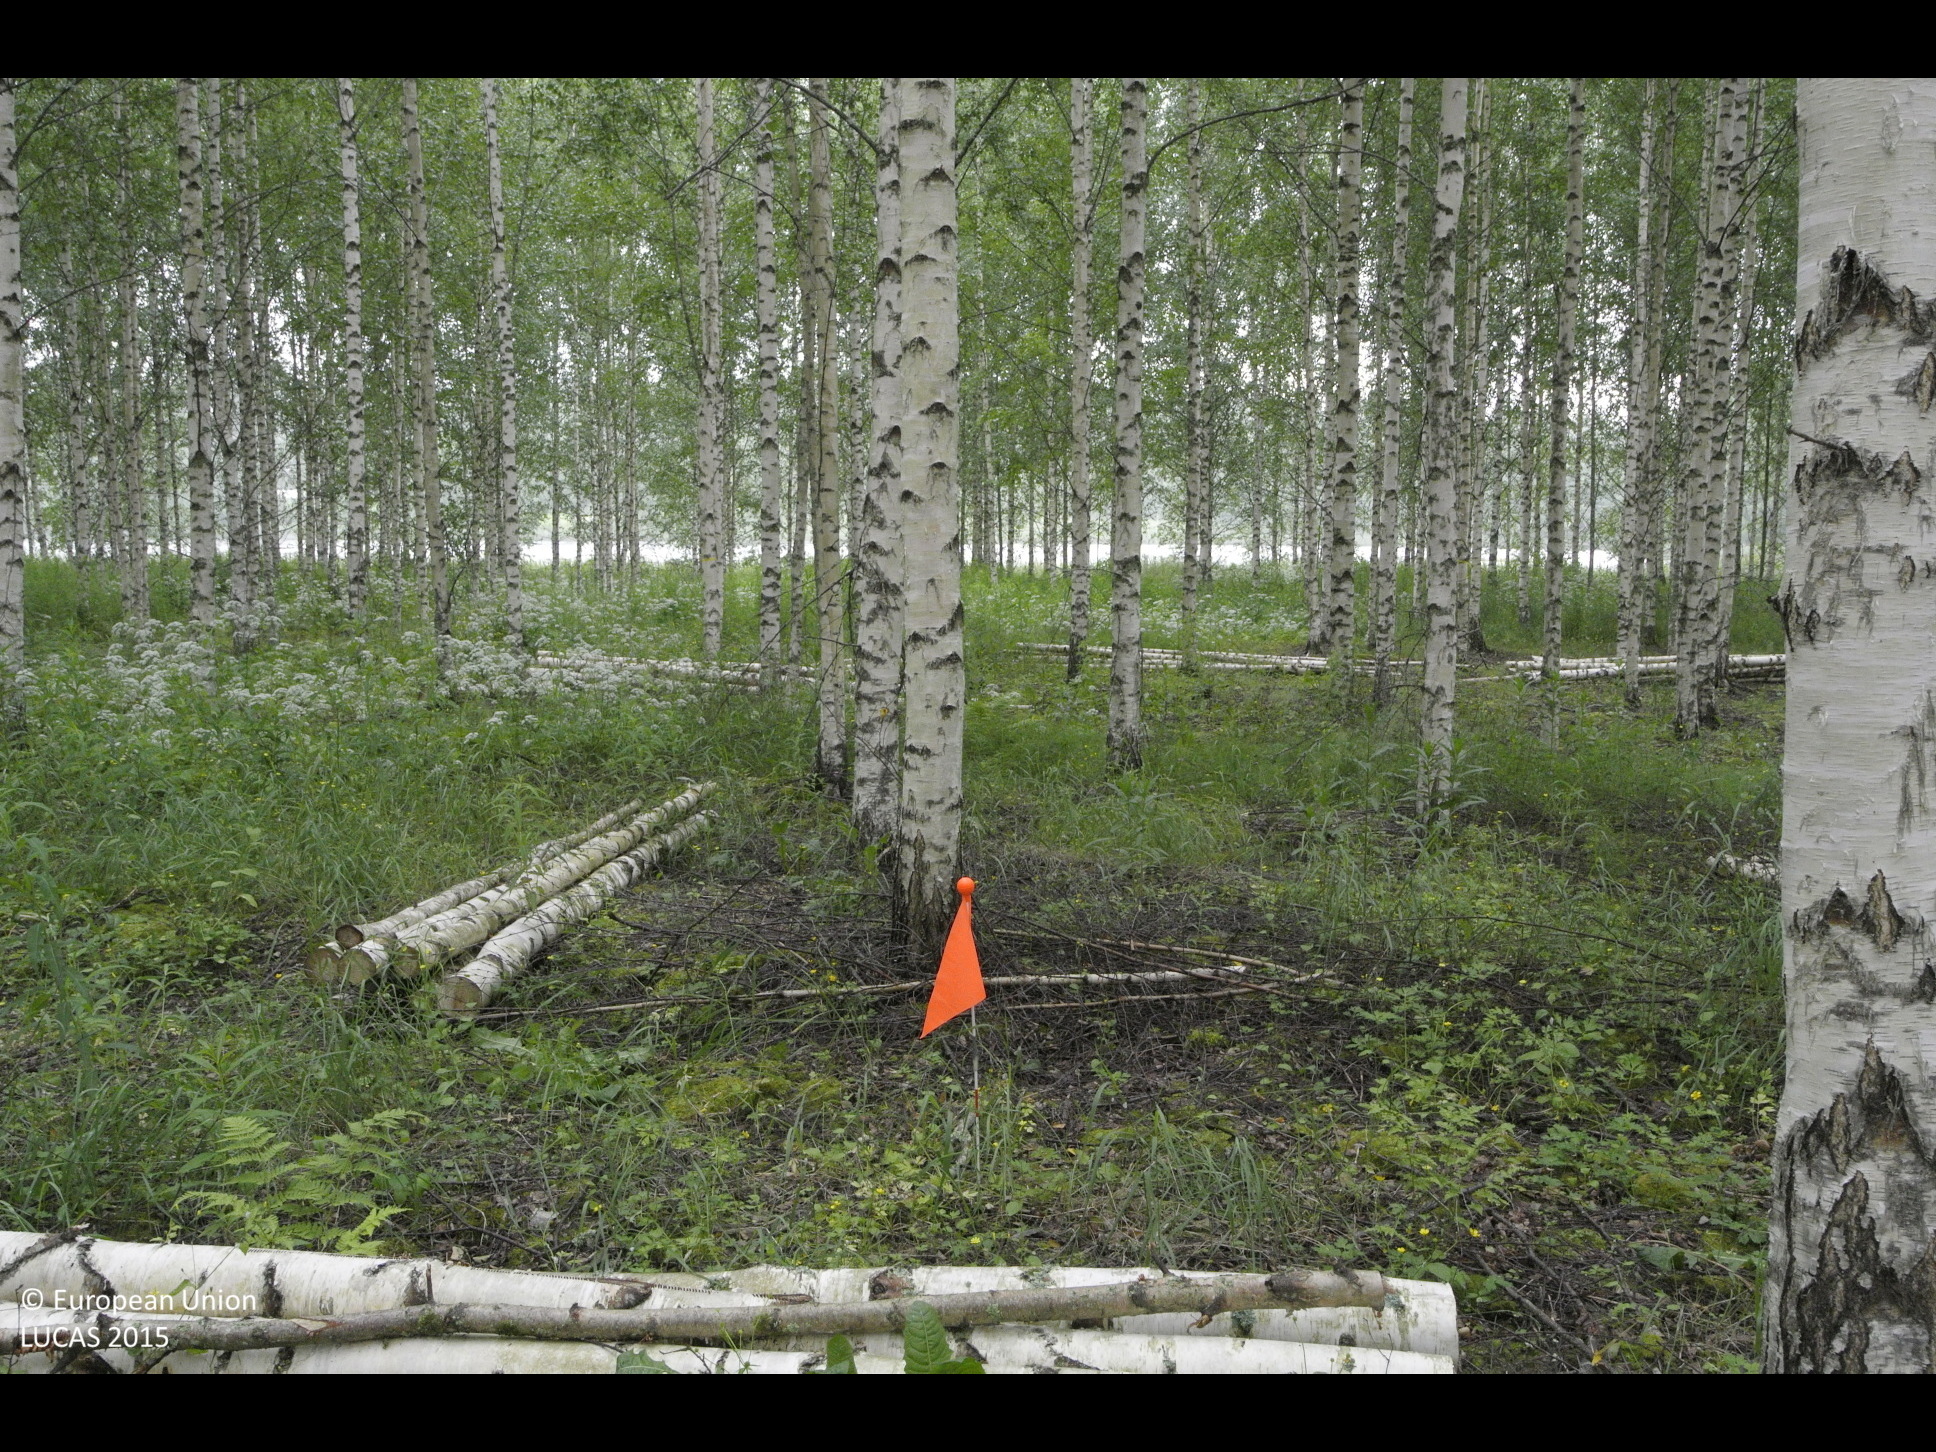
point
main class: Woodland
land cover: Broadleaved woodland
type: non-riverine alder, birch or aspen forest
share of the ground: > 75 %
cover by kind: broadleaved forest trees 85 %, herbaceous plants 15 %
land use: Forestry
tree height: > 5 m
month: July
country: FI
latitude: 61.5483
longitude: 25.8019
